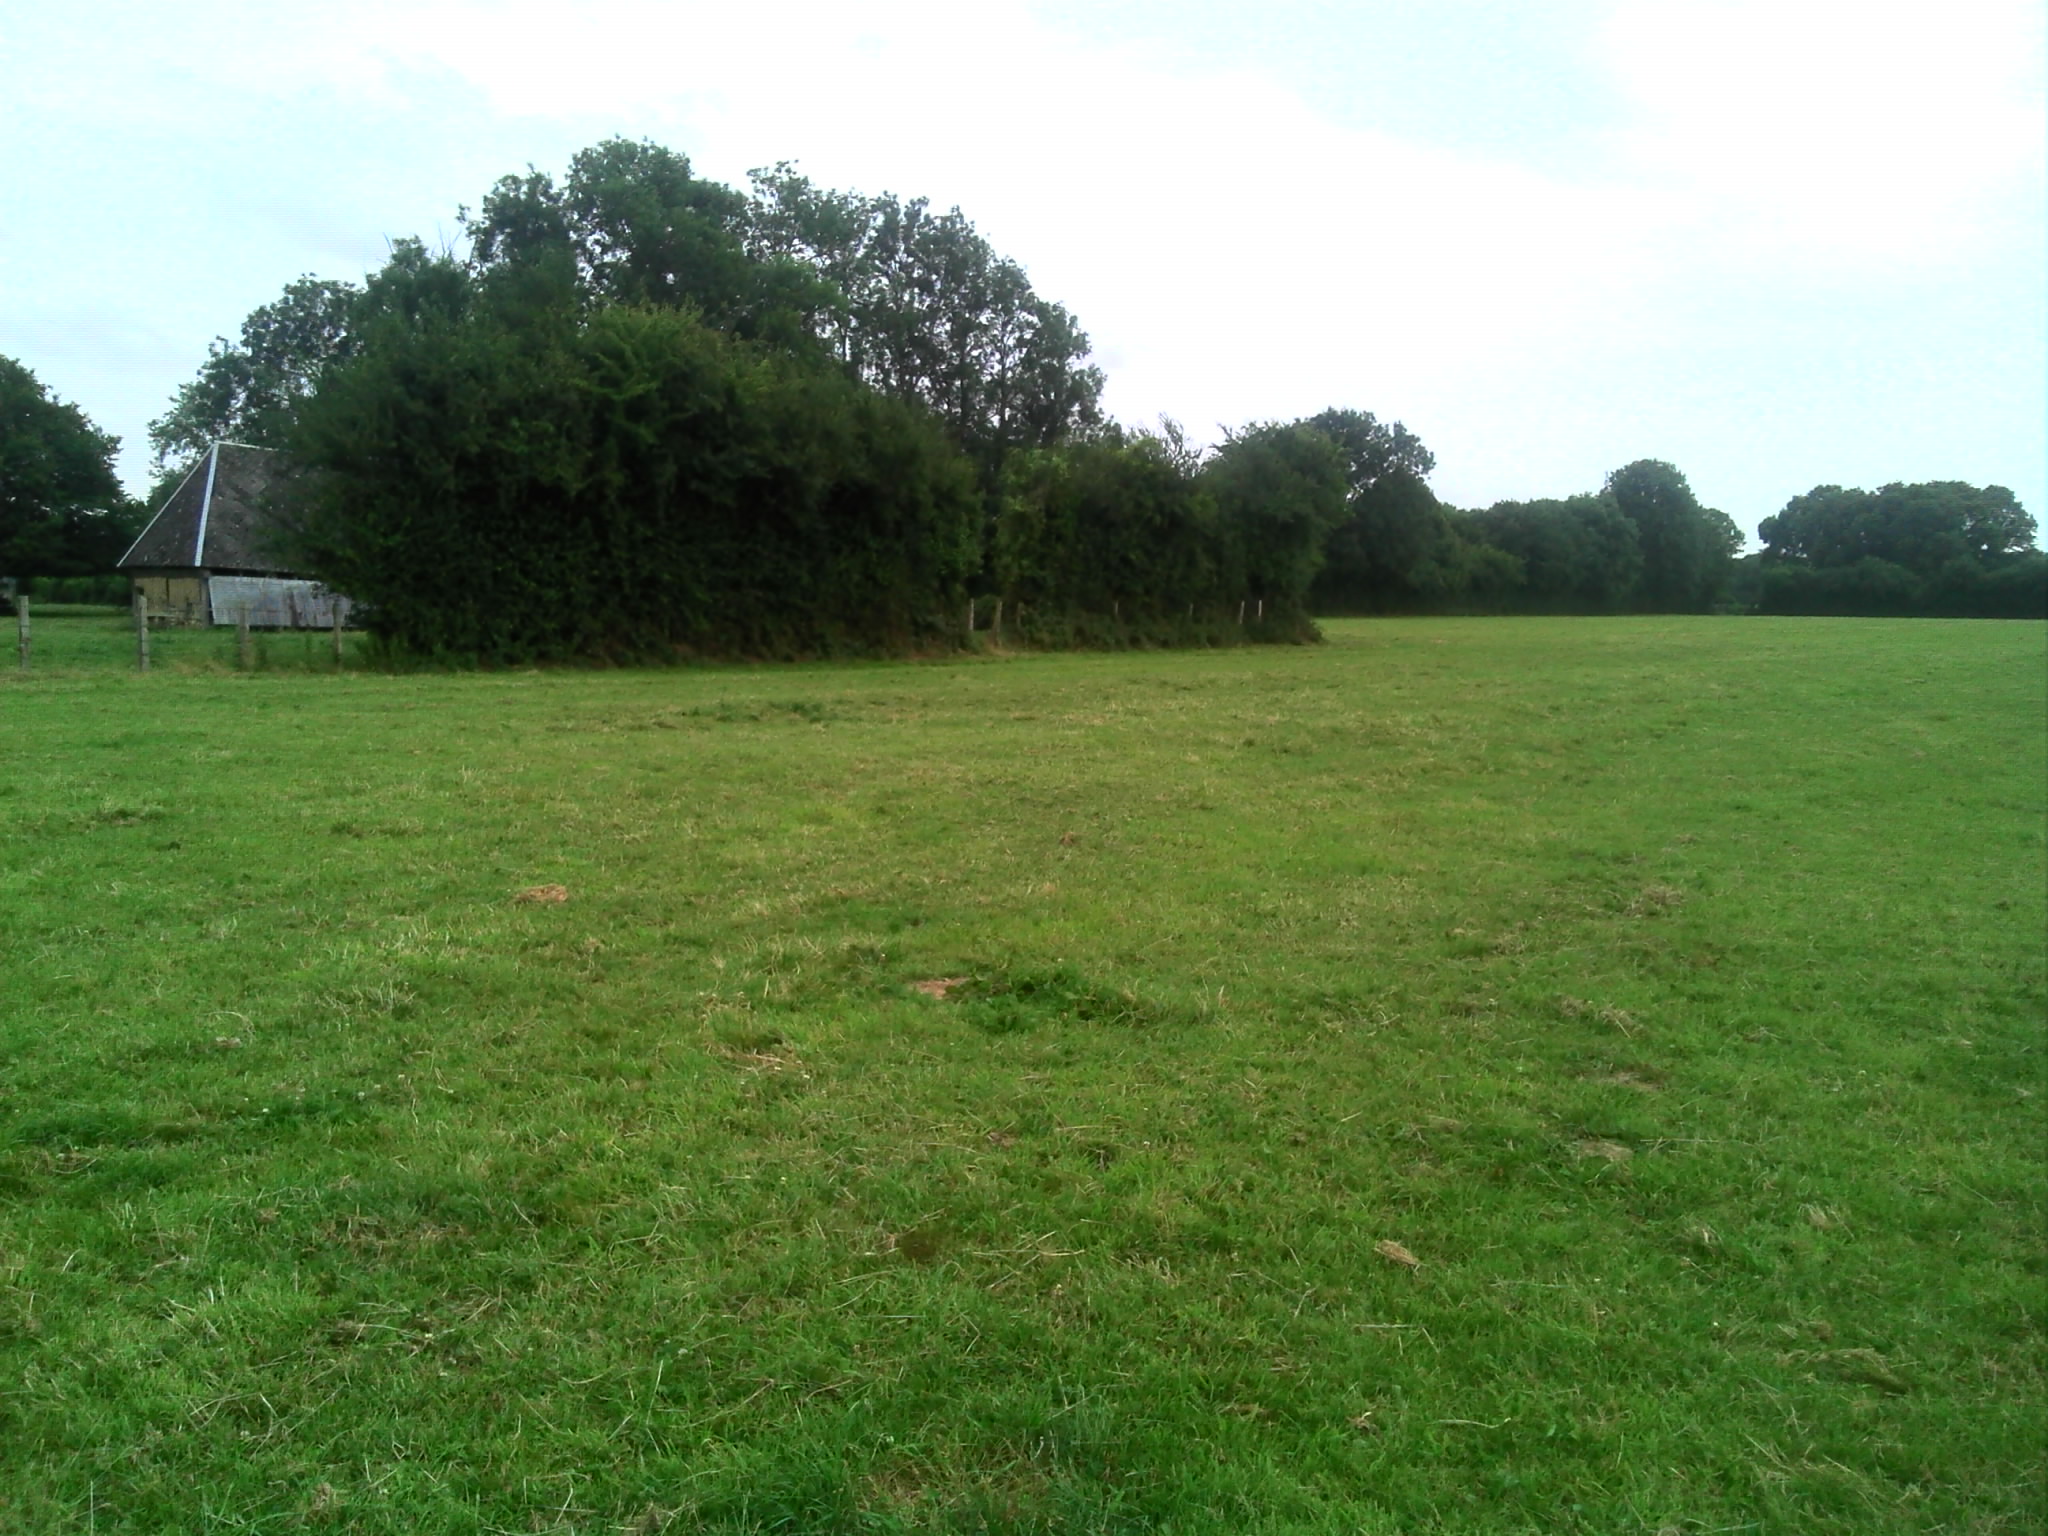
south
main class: Grassland
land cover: Grassland without tree/shrub cover
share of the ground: > 75 %
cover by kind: herbaceous plants 100 %
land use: Agriculture (excluding fallow land and kitchen gardens)
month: July
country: FR
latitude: 49.0419
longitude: 0.6867
